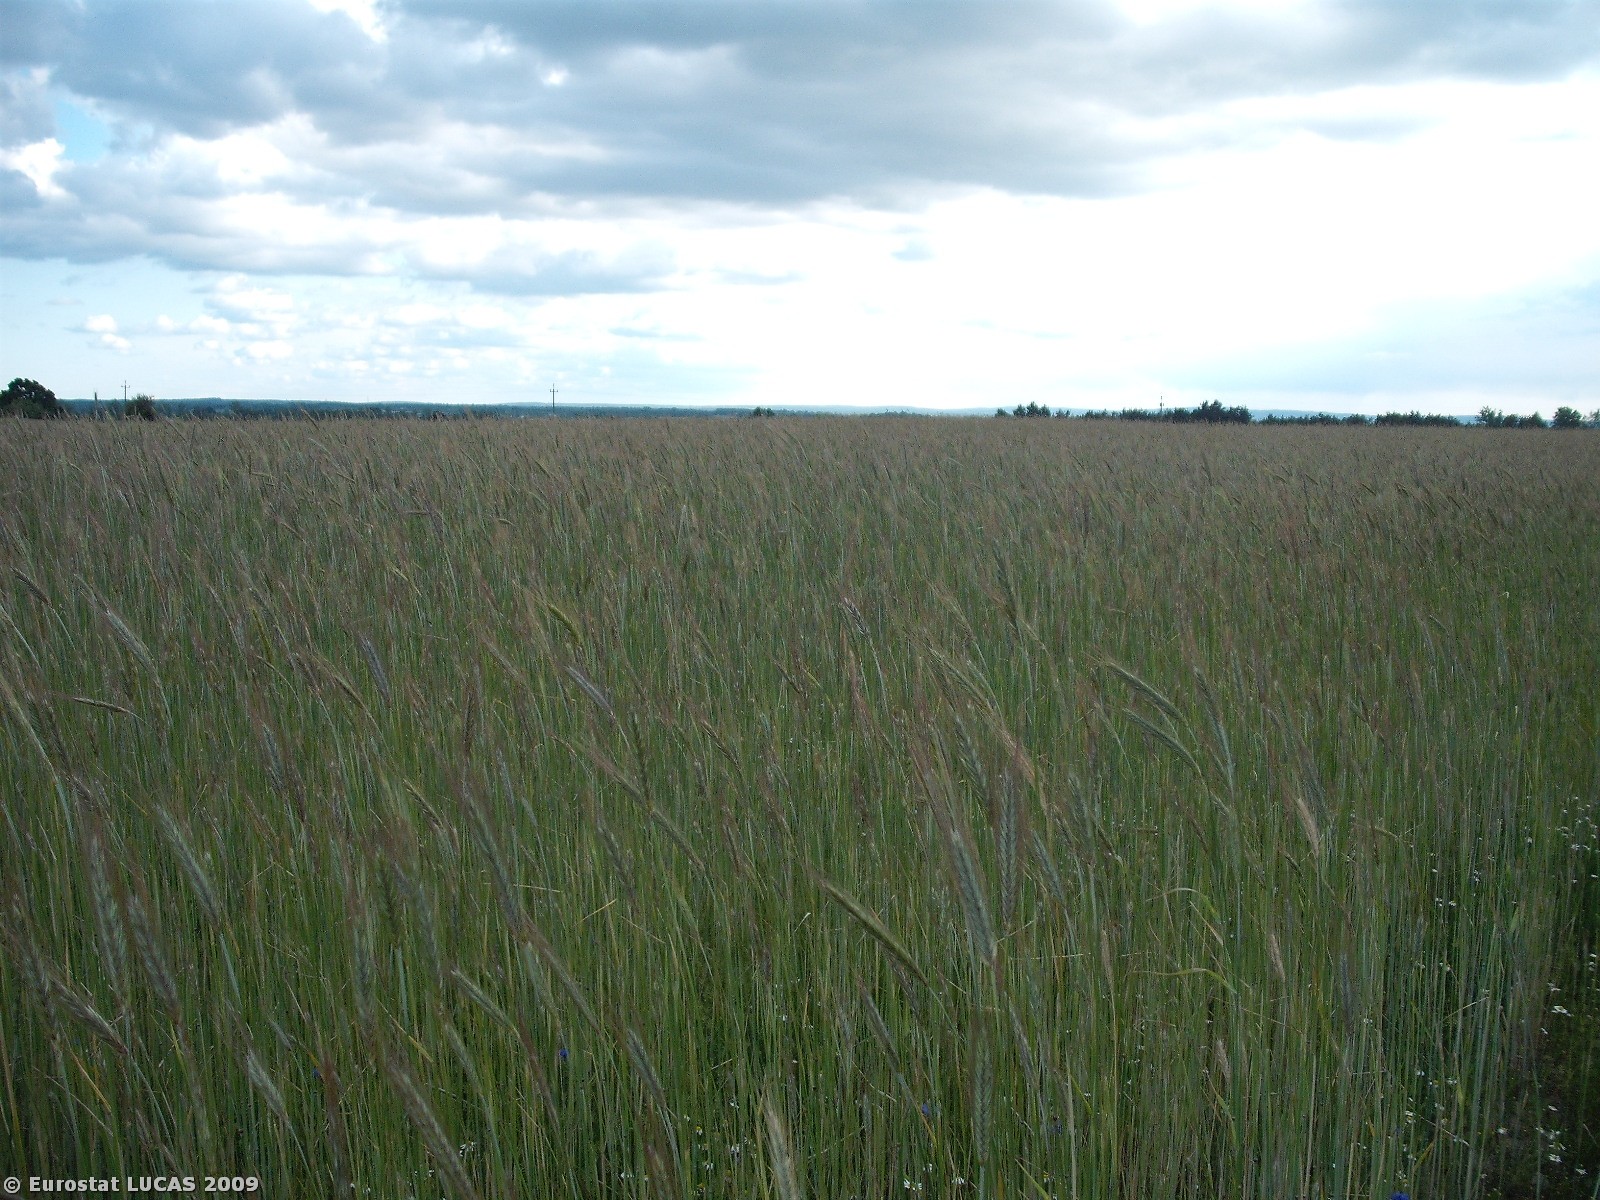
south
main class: Cropland
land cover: Rye
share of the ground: > 75 %
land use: Agriculture (excluding fallow land and kitchen gardens)
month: June
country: PL
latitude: 51.3137
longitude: 20.8748
